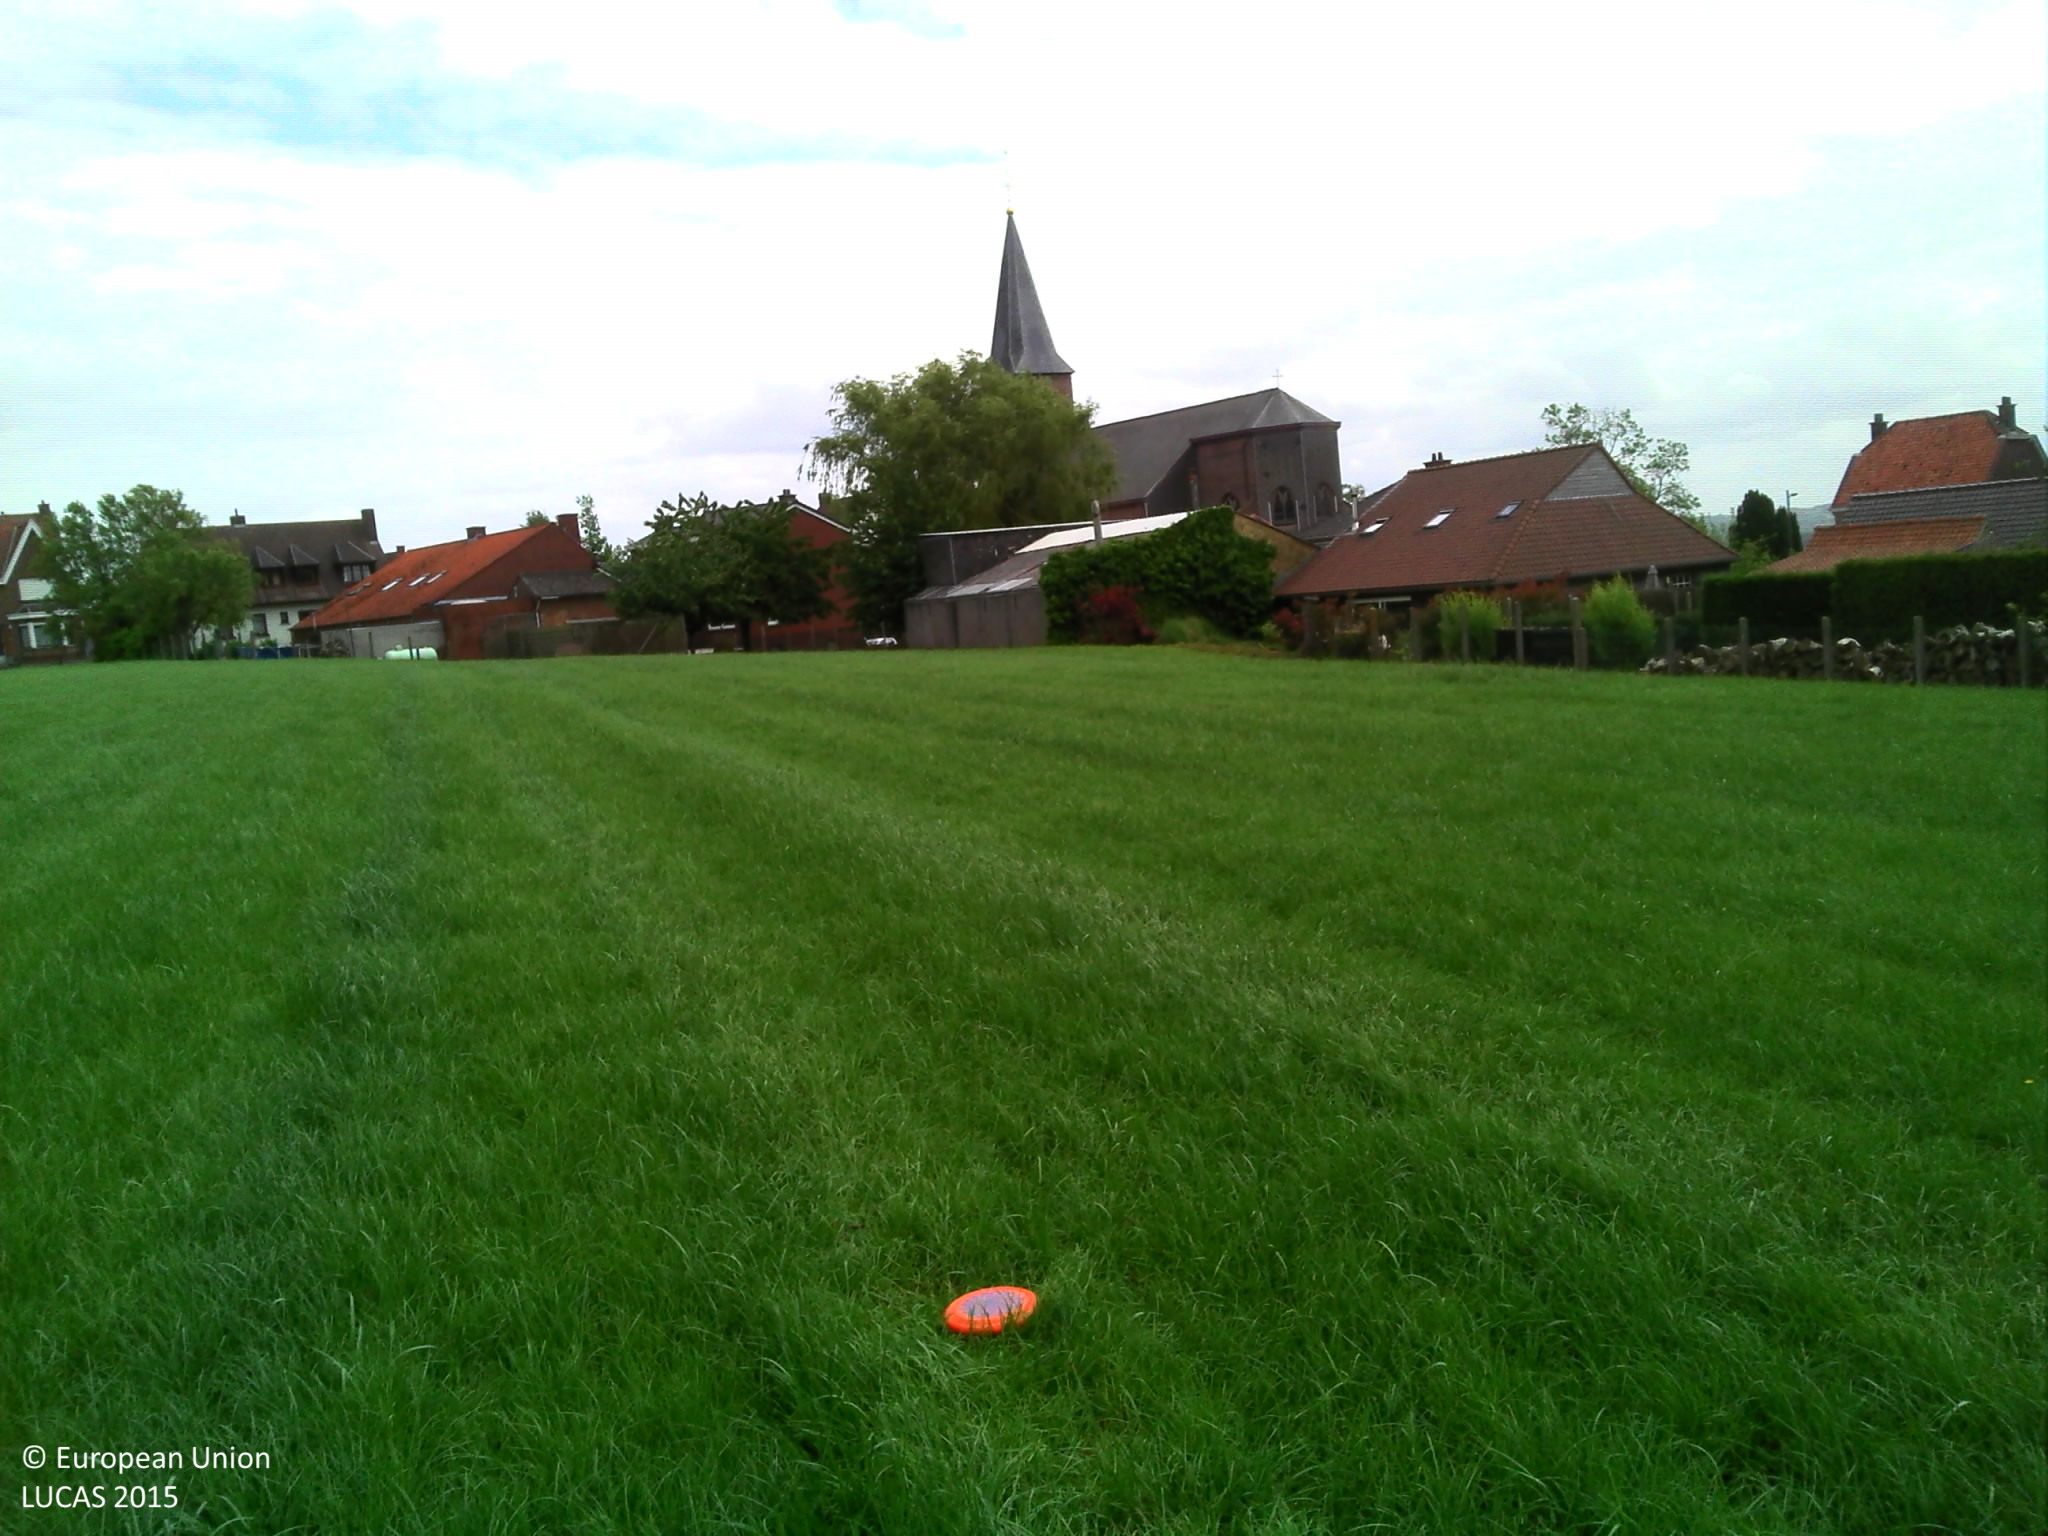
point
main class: Cropland
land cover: Temporary grasslands
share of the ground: > 75 %
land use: Agriculture (excluding fallow land and kitchen gardens)
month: June
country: BE
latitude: 50.8288
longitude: 3.5040
